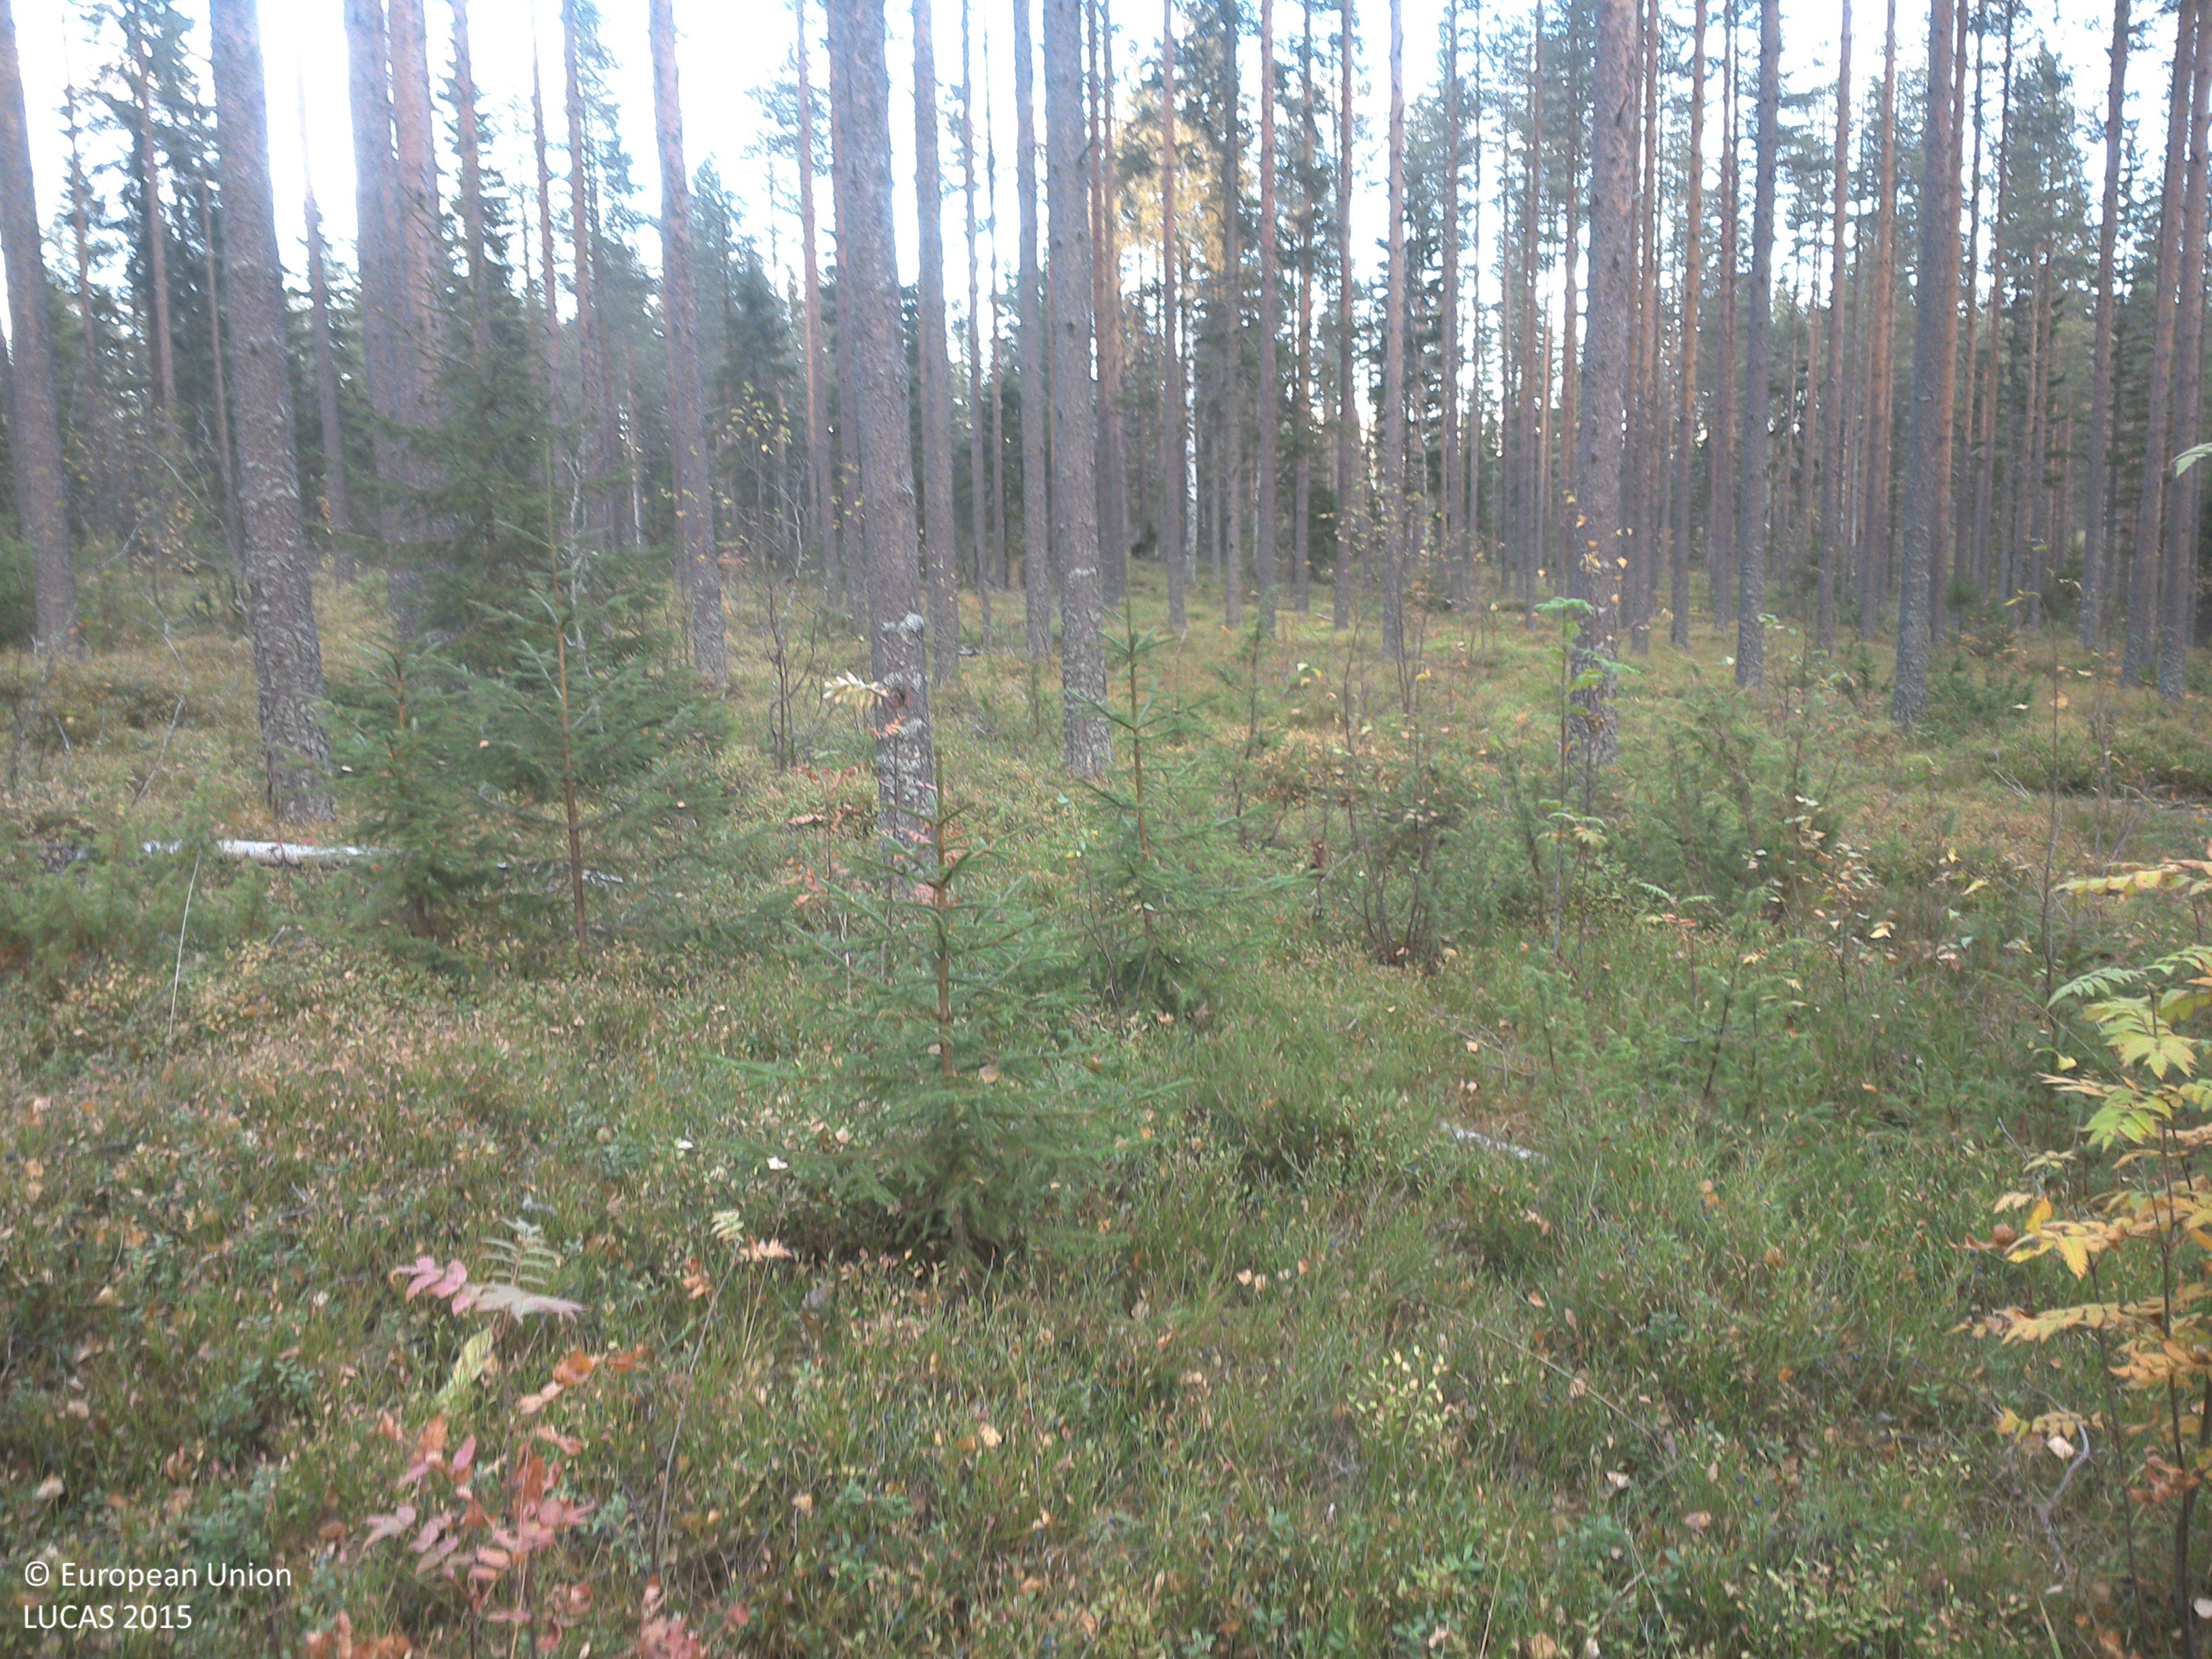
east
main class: Woodland
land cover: Pine dominated mixed woodland
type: boreal forest
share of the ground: 25 - 50 %
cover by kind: shrubs 50 %, coniferous forest trees 30 %, broadleaved forest trees 20 %
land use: Forestry
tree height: > 5 m
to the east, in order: Pine dominated mixed woodland; Pine dominated coniferous woodland; Other coniferous woodland; Pine dominated mixed woodland; Tracks; Pine dominated mixed woodland; Other mixed woodland; Pine dominated coniferous woodland; Other coniferous woodland; Tracks; Other coniferous woodland
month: October
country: SE
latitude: 63.8676
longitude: 19.9304
